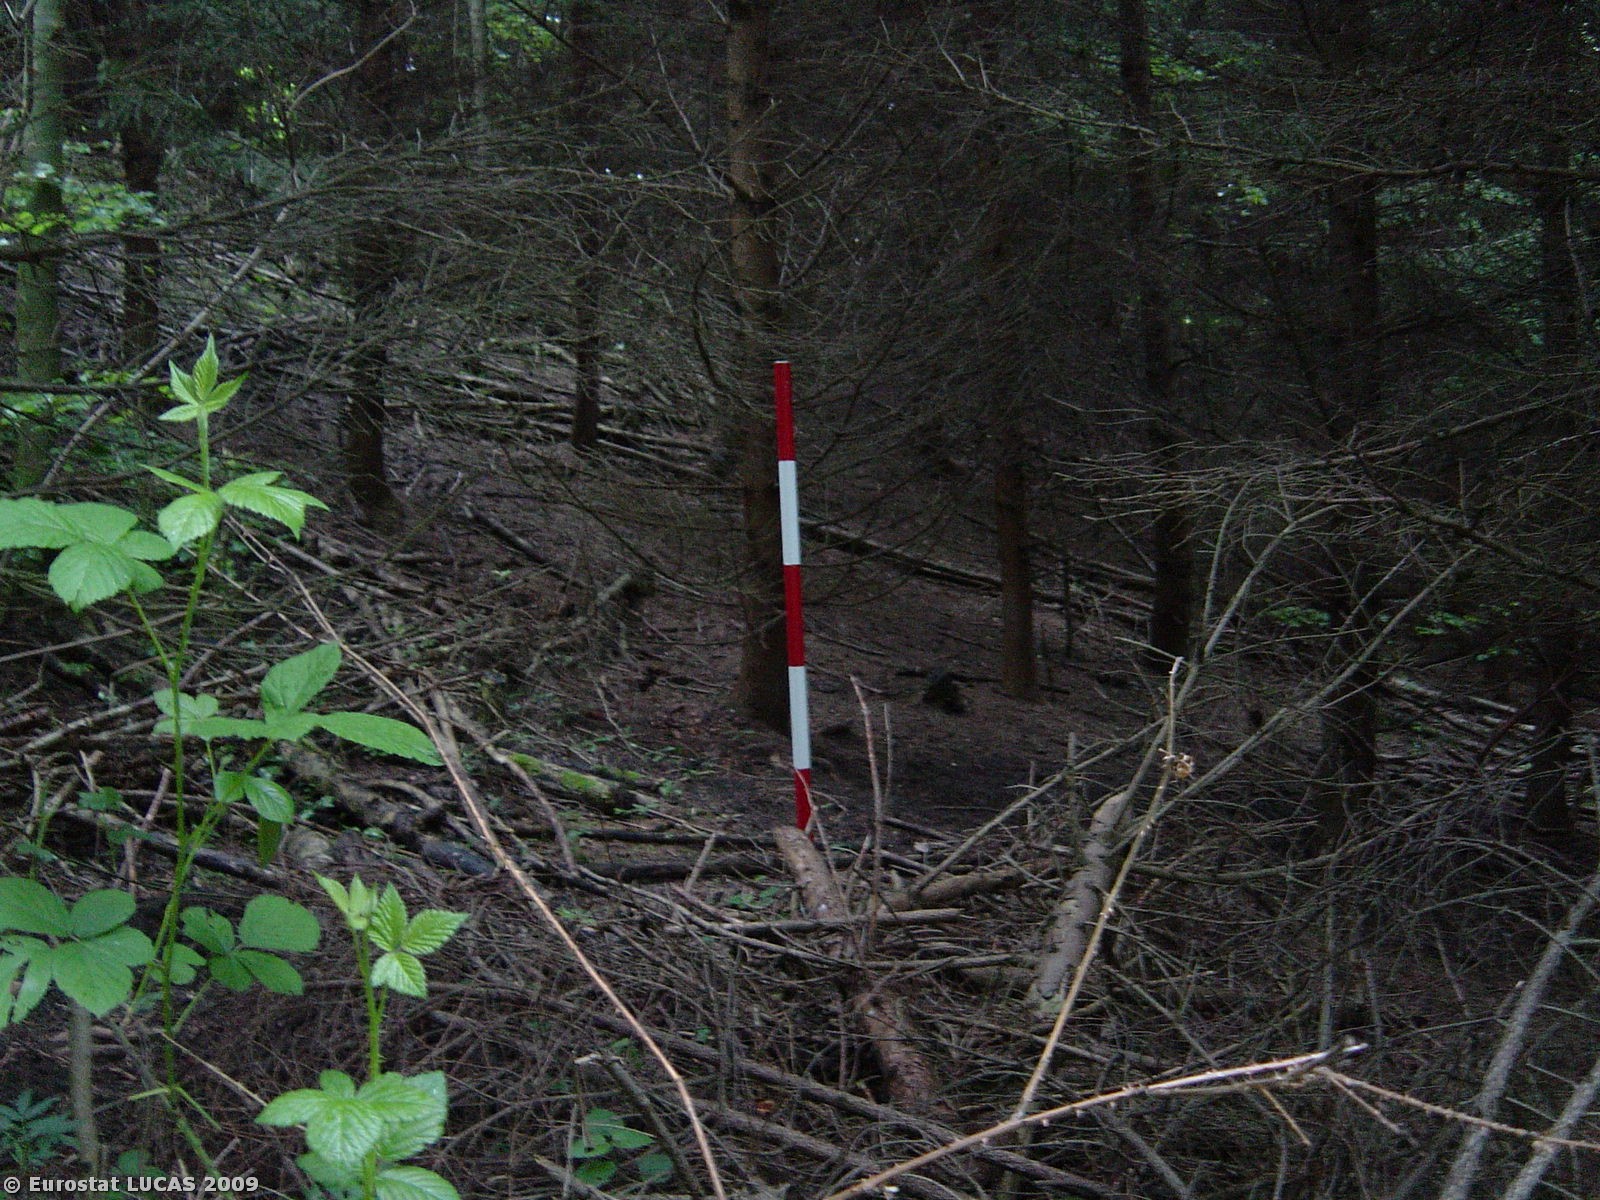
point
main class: Woodland
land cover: Coniferous woodland
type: hemiboreal forest and nemoral coniferous forest and mixed broadleaved-coniferous forest
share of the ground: > 75 %
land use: Forestry
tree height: > 5 m
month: June
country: CZ
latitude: 49.2024
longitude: 17.1329
